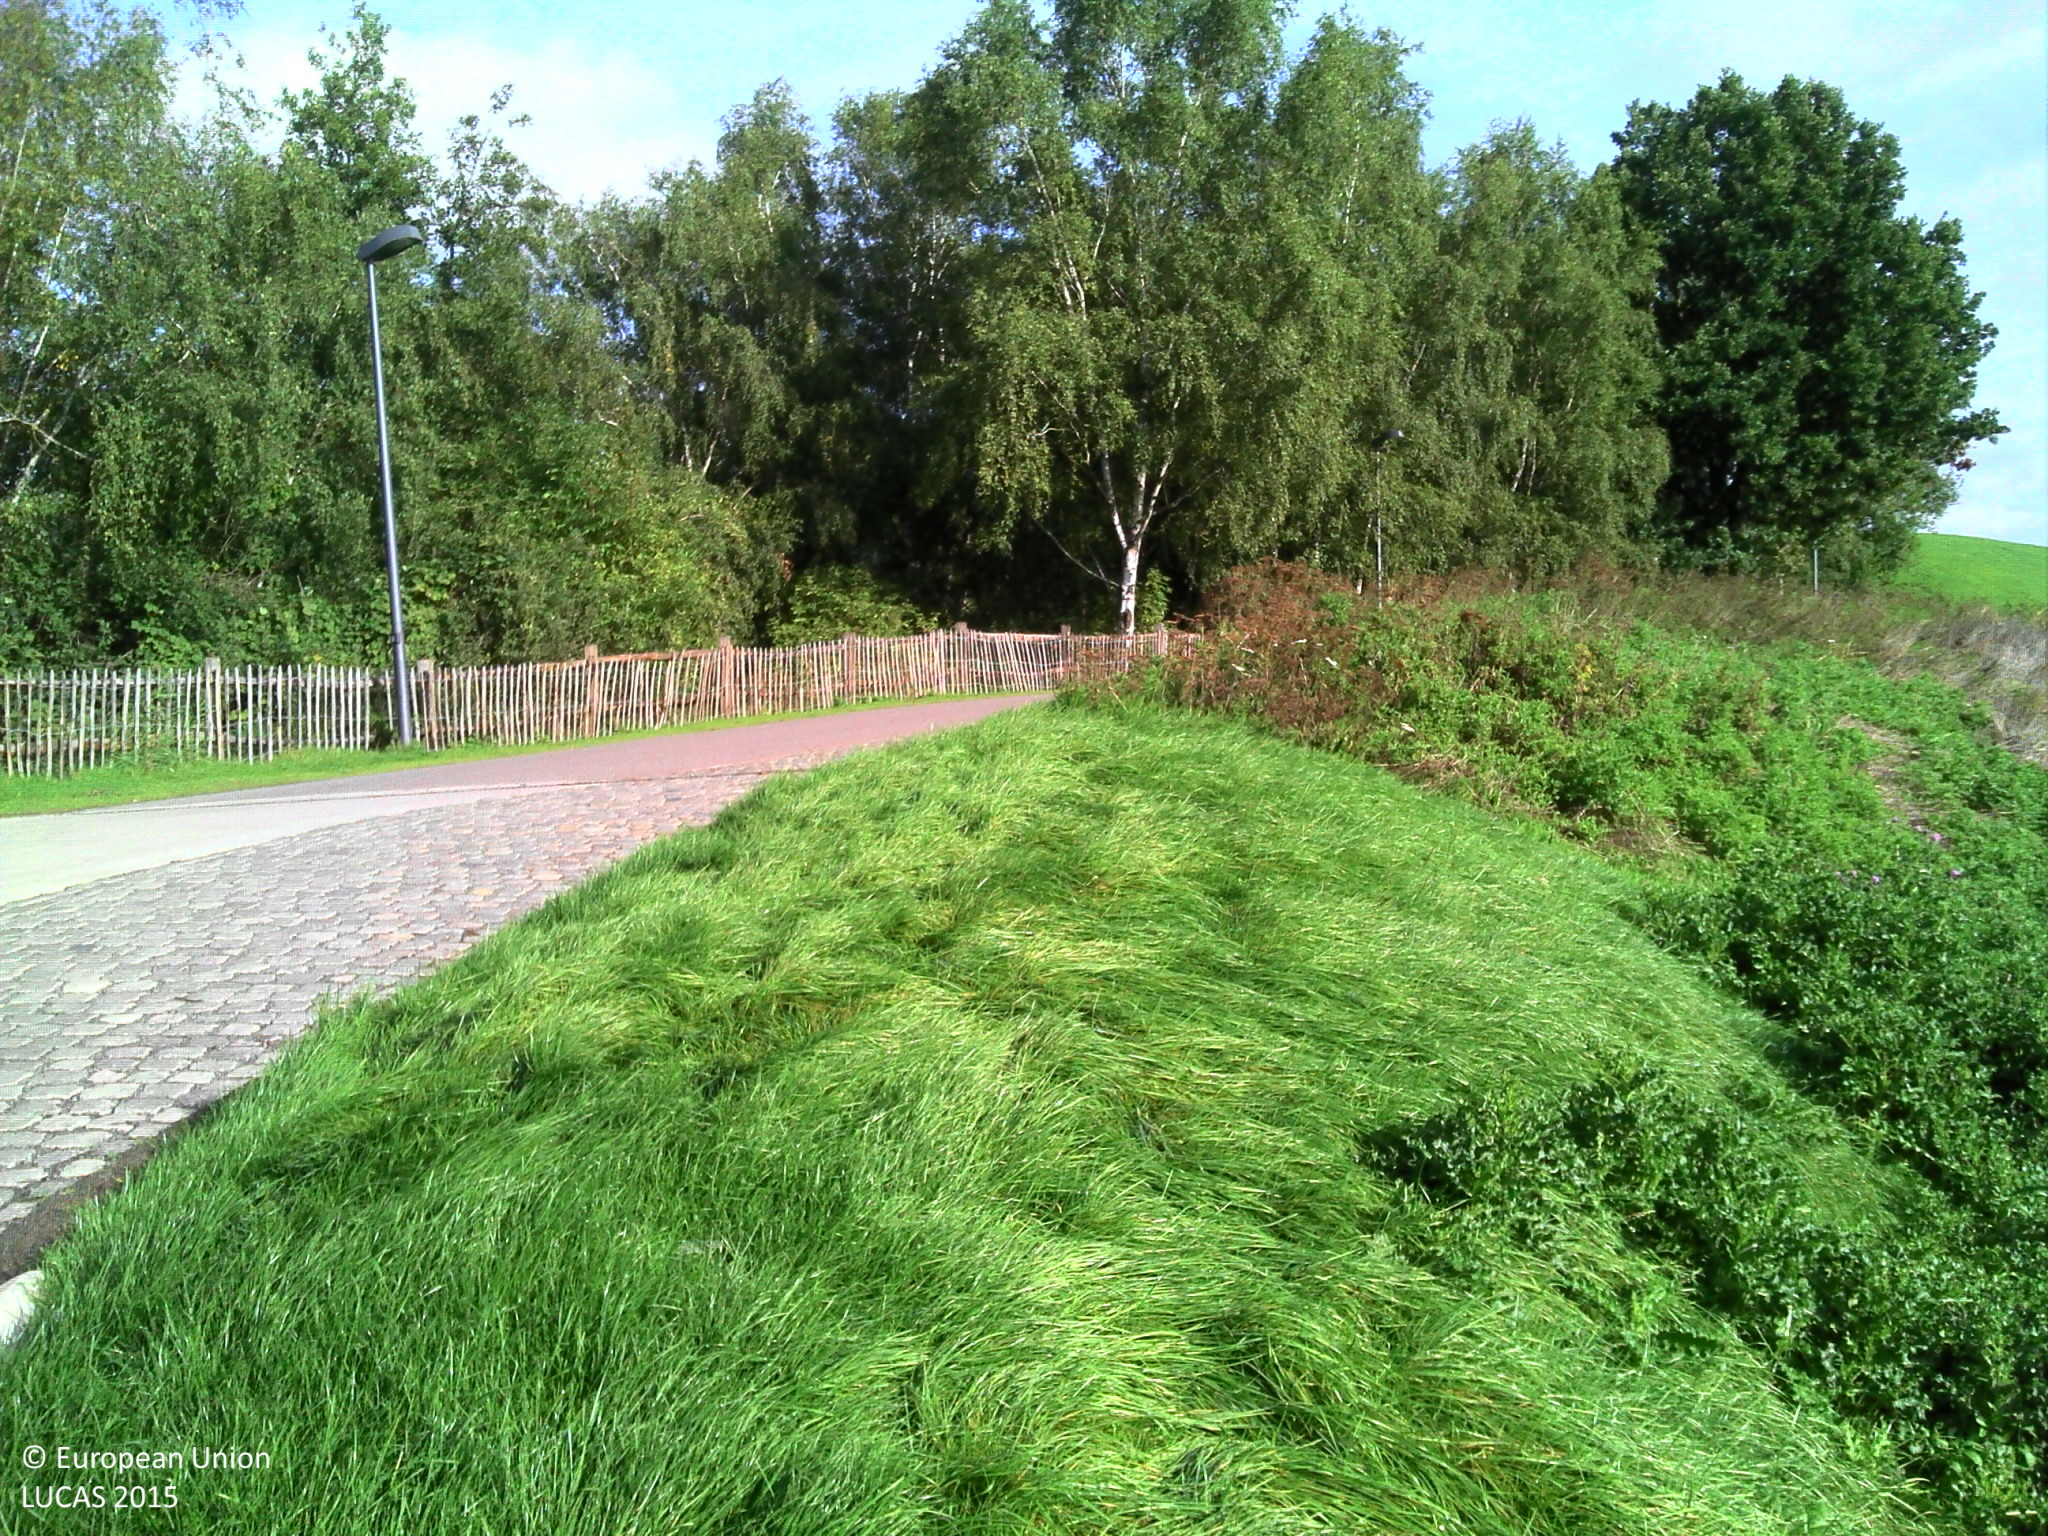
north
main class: Grassland
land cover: Grassland without tree/shrub cover
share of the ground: > 75 %
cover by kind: herbaceous plants 100 %
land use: Amenities, museums, leisure
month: September
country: BE
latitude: 51.0913
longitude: 4.3842
